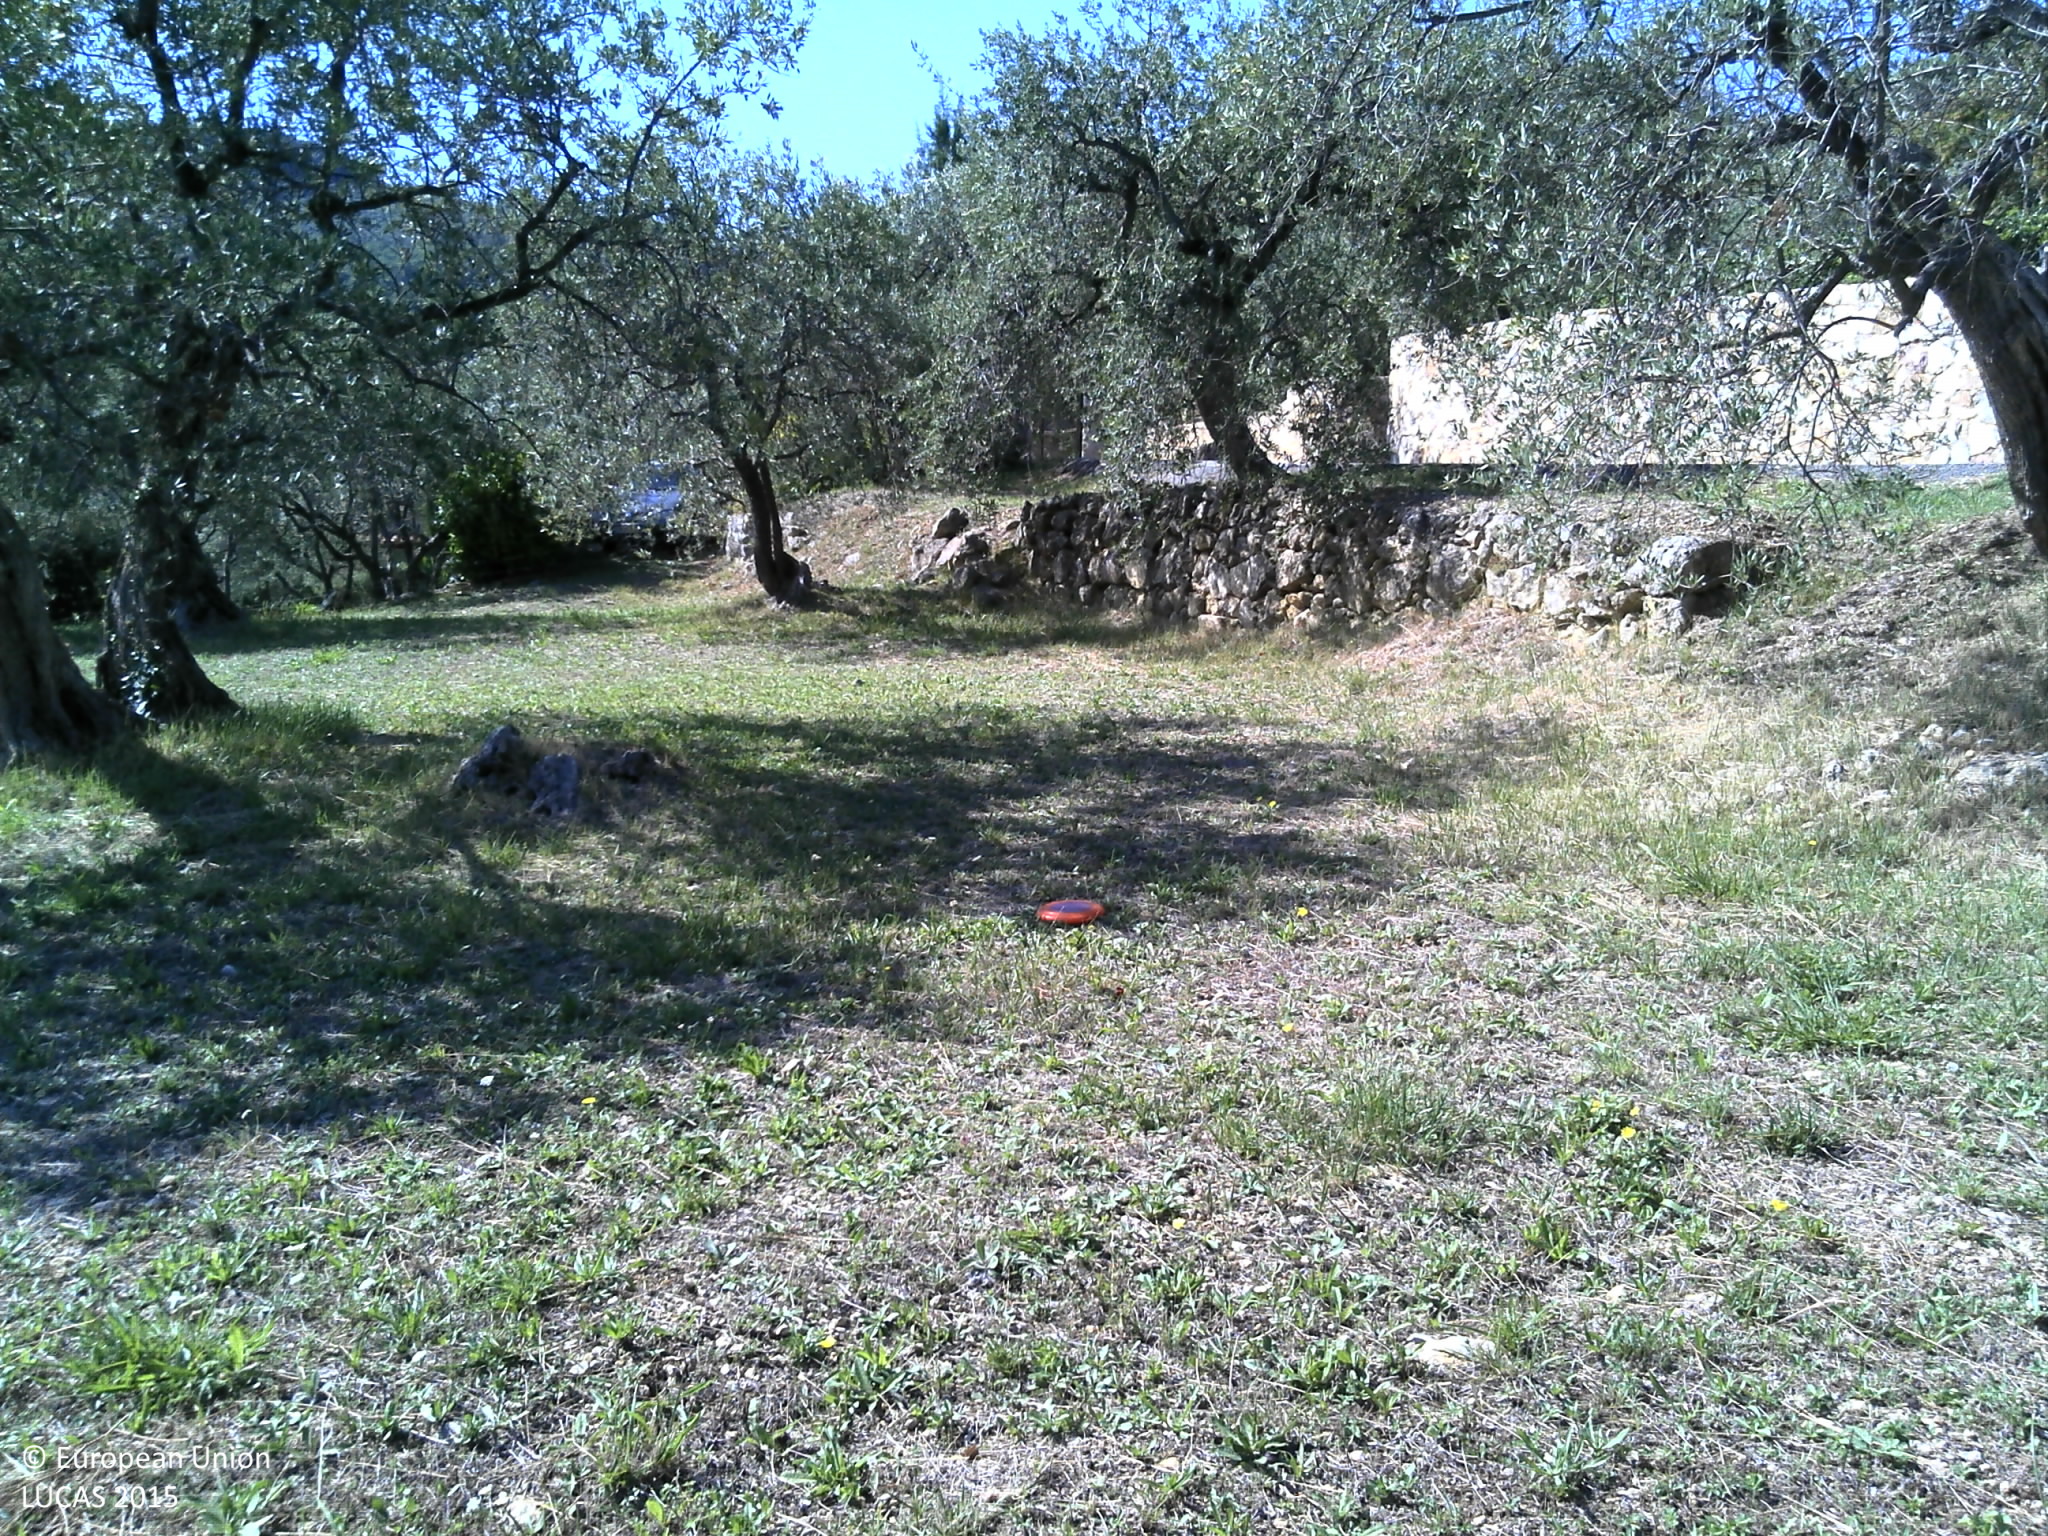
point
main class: Cropland
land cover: Olive groves
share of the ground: 25 - 50 %
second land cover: Grassland without tree/shrub cover
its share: 50 - 75 %
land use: Agriculture (excluding fallow land and kitchen gardens)
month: September
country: FR
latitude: 43.6276
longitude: 6.6245
